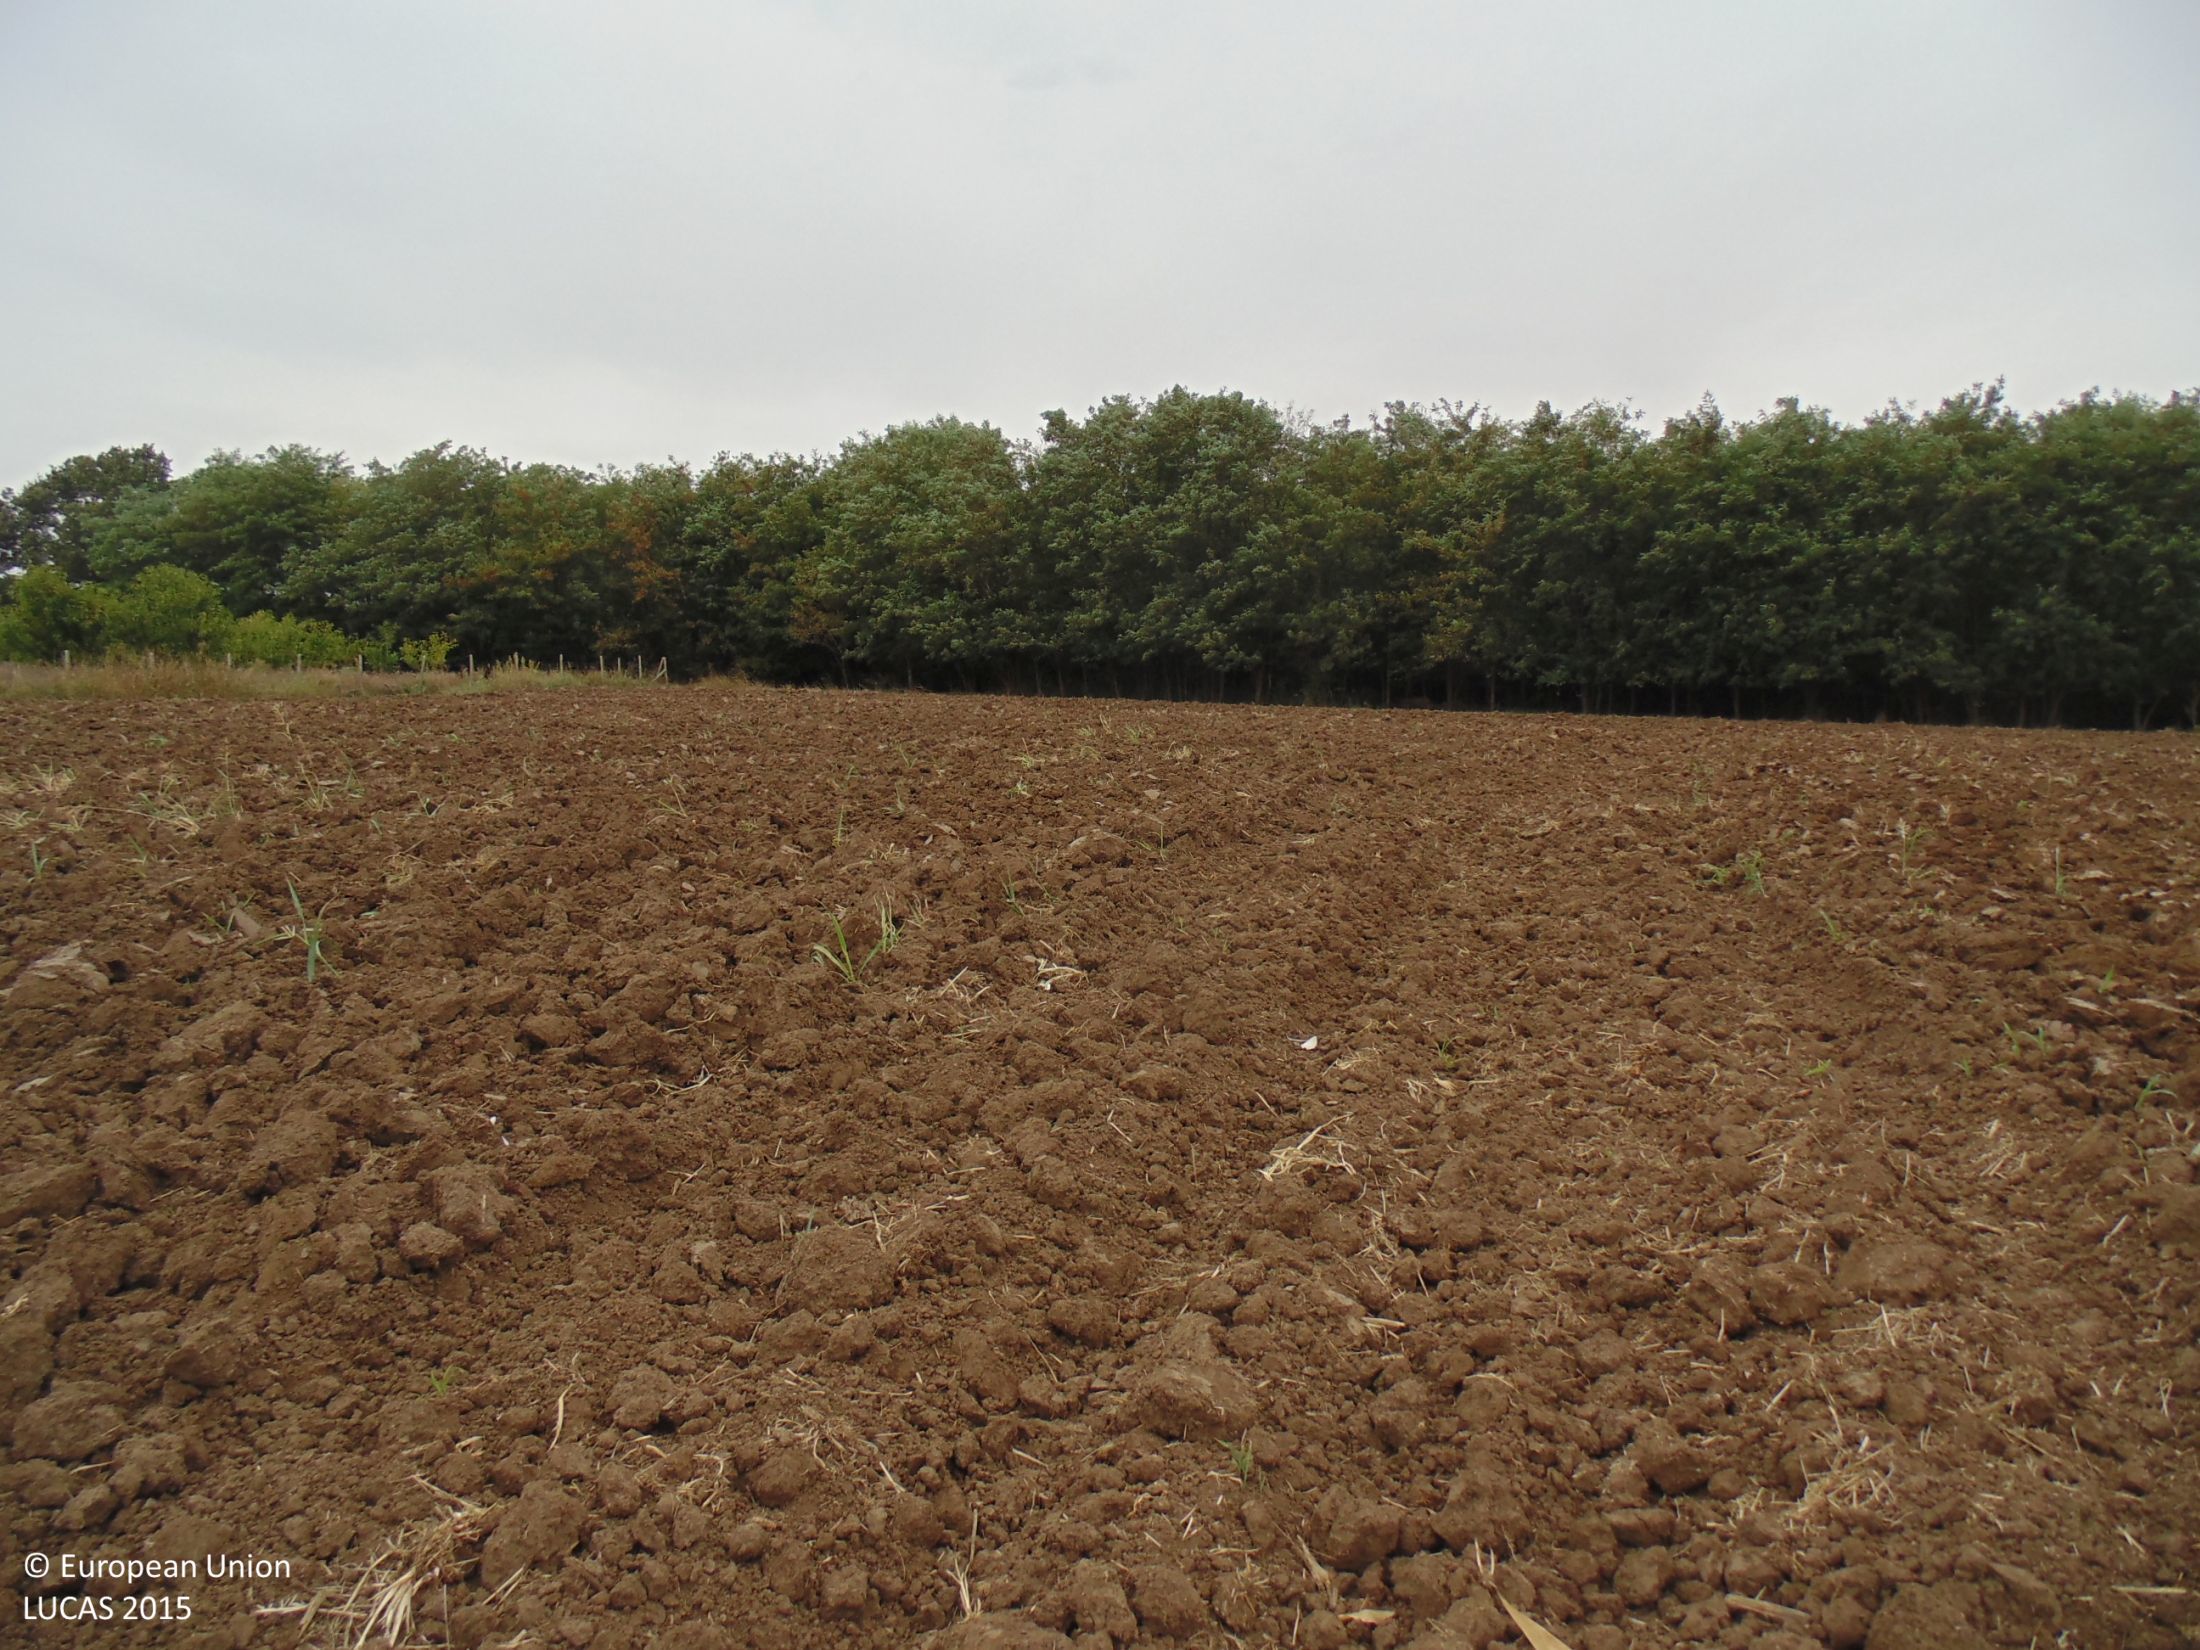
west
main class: Cropland
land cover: Common wheat
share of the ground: < 10 %
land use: Agriculture (excluding fallow land and kitchen gardens)
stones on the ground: < 10 %
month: September
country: BG
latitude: 43.9504
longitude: 26.9813
